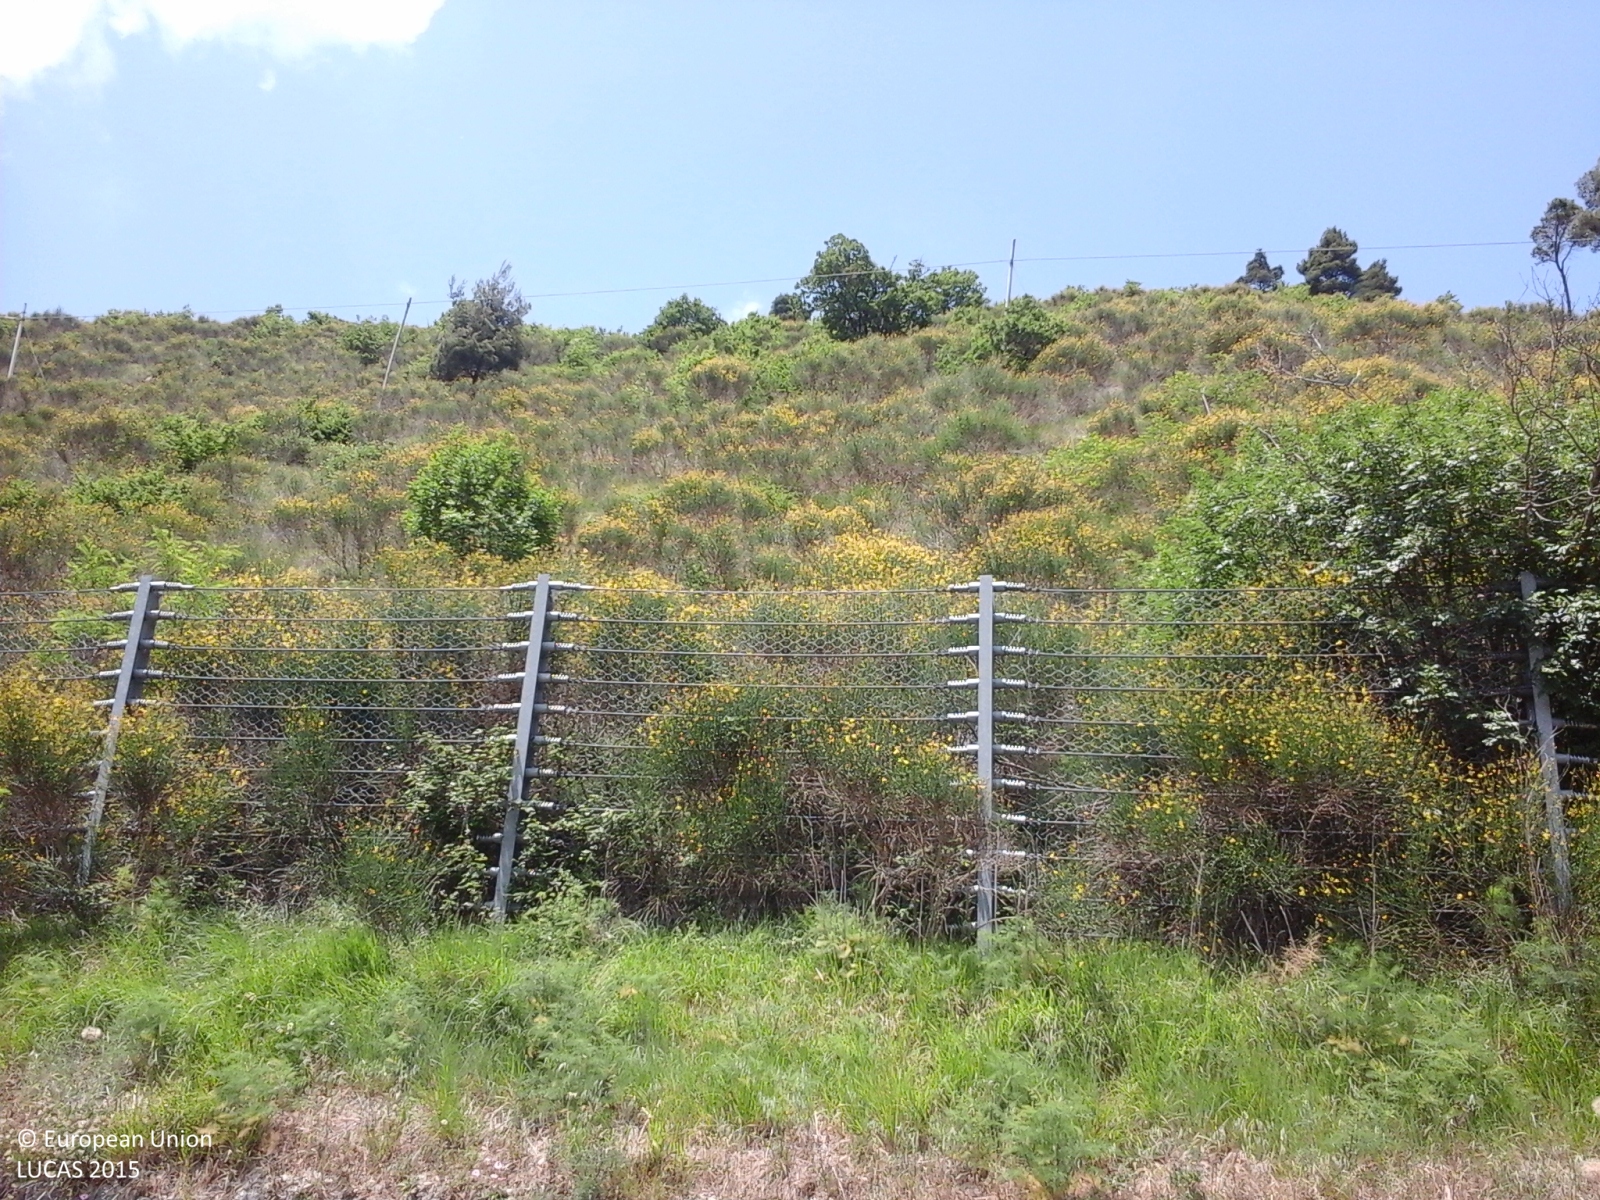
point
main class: Shrubland
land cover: Shrubland with sparse tree cover
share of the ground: > 75 %
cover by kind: shrubs 75 %, herbaceous plants 20 %, coniferous forest trees 5 %
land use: Semi-natural and natural areas not in use
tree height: > 5 m
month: May
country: IT
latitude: 41.2365
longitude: 15.1716
